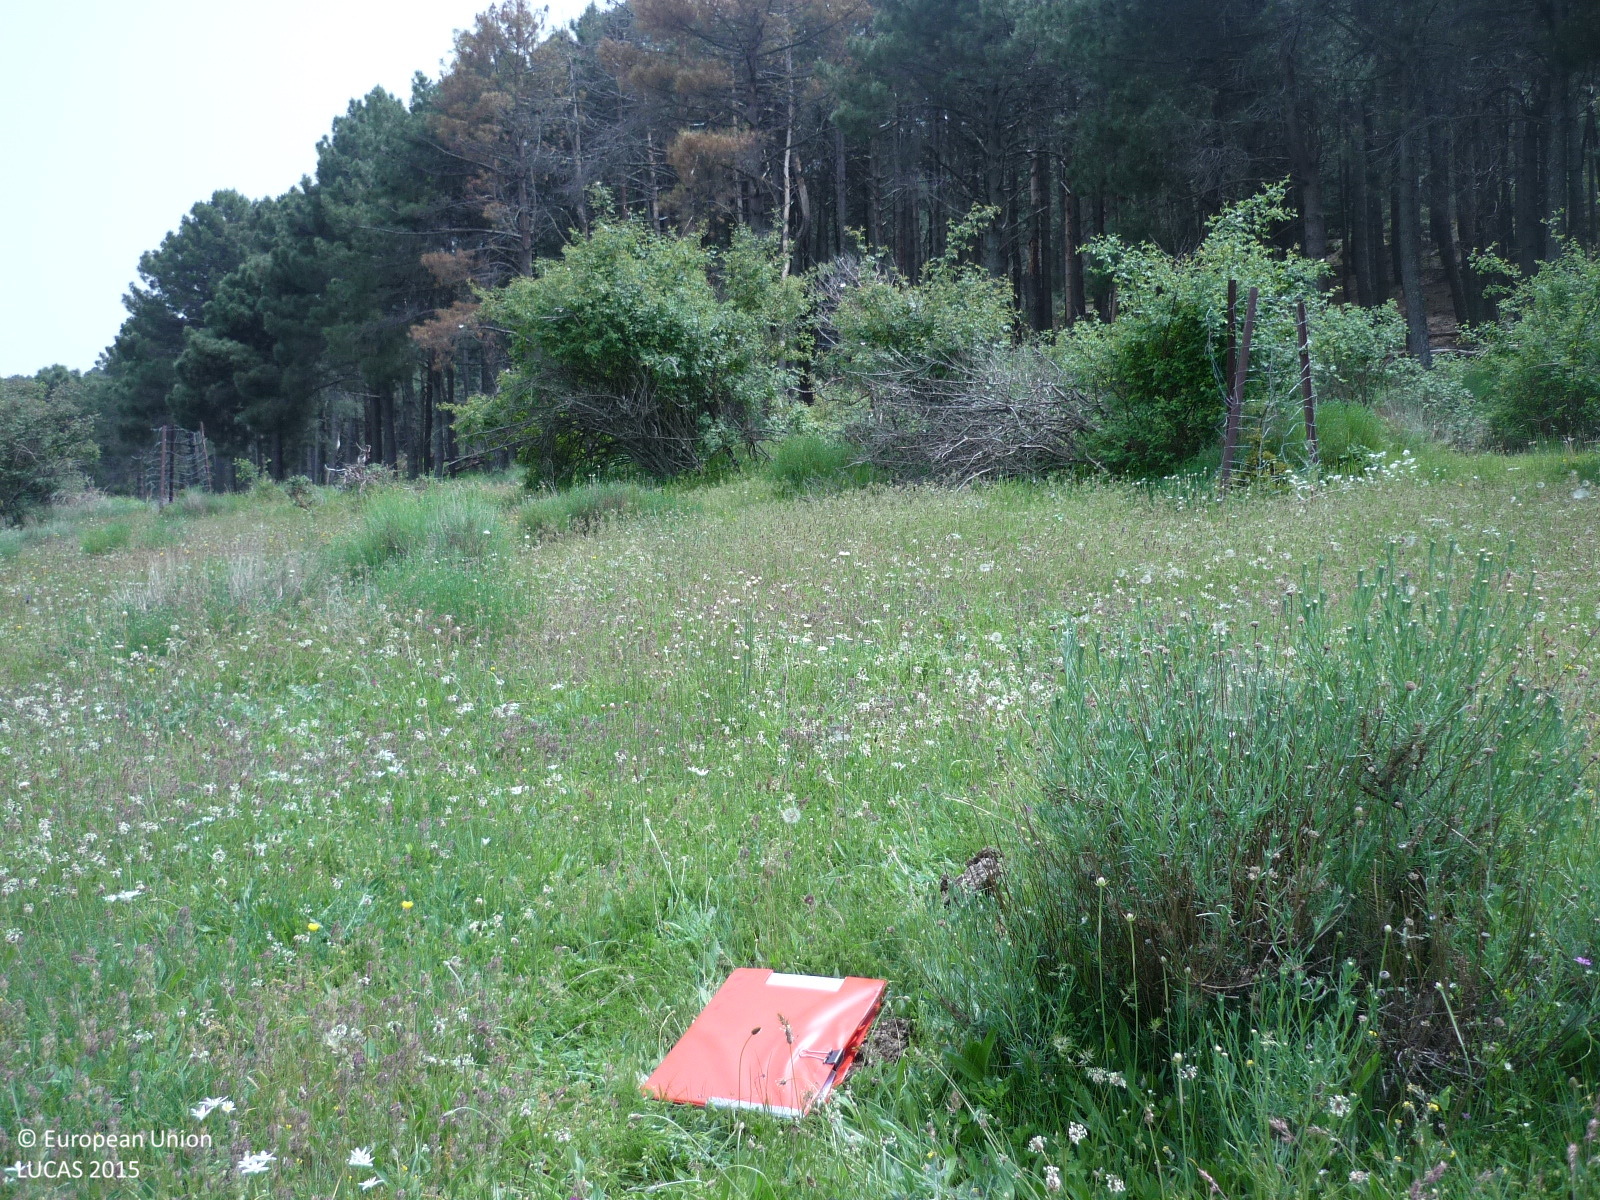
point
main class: Grassland
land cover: Grassland without tree/shrub cover
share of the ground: > 75 %
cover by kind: herbaceous plants 90 %, shrubs 5 %, unconsolidated bare surface 5 %
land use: Agriculture (excluding fallow land and kitchen gardens)
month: May
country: ES
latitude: 40.7546
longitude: -3.9149
